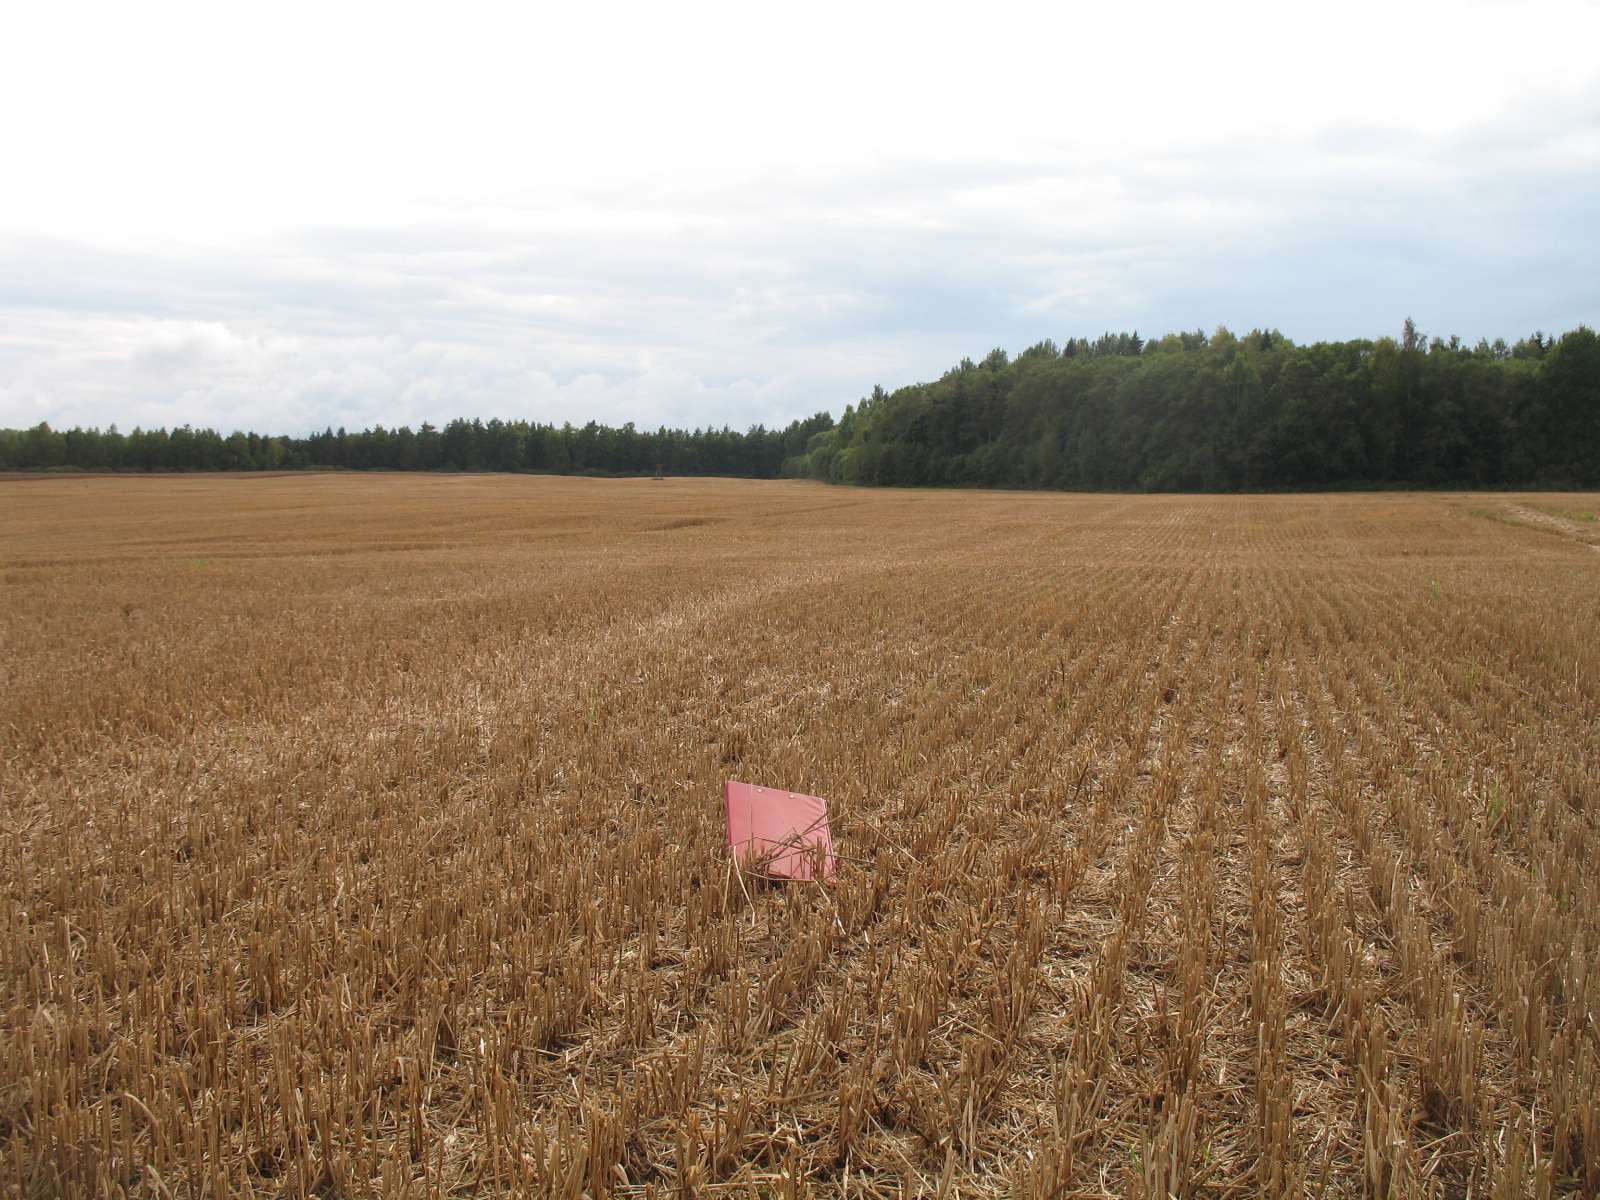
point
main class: Cropland
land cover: Common wheat
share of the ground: < 10 %
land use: Agriculture (excluding fallow land and kitchen gardens)
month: September
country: LV
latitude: 56.0872
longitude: 25.8983
